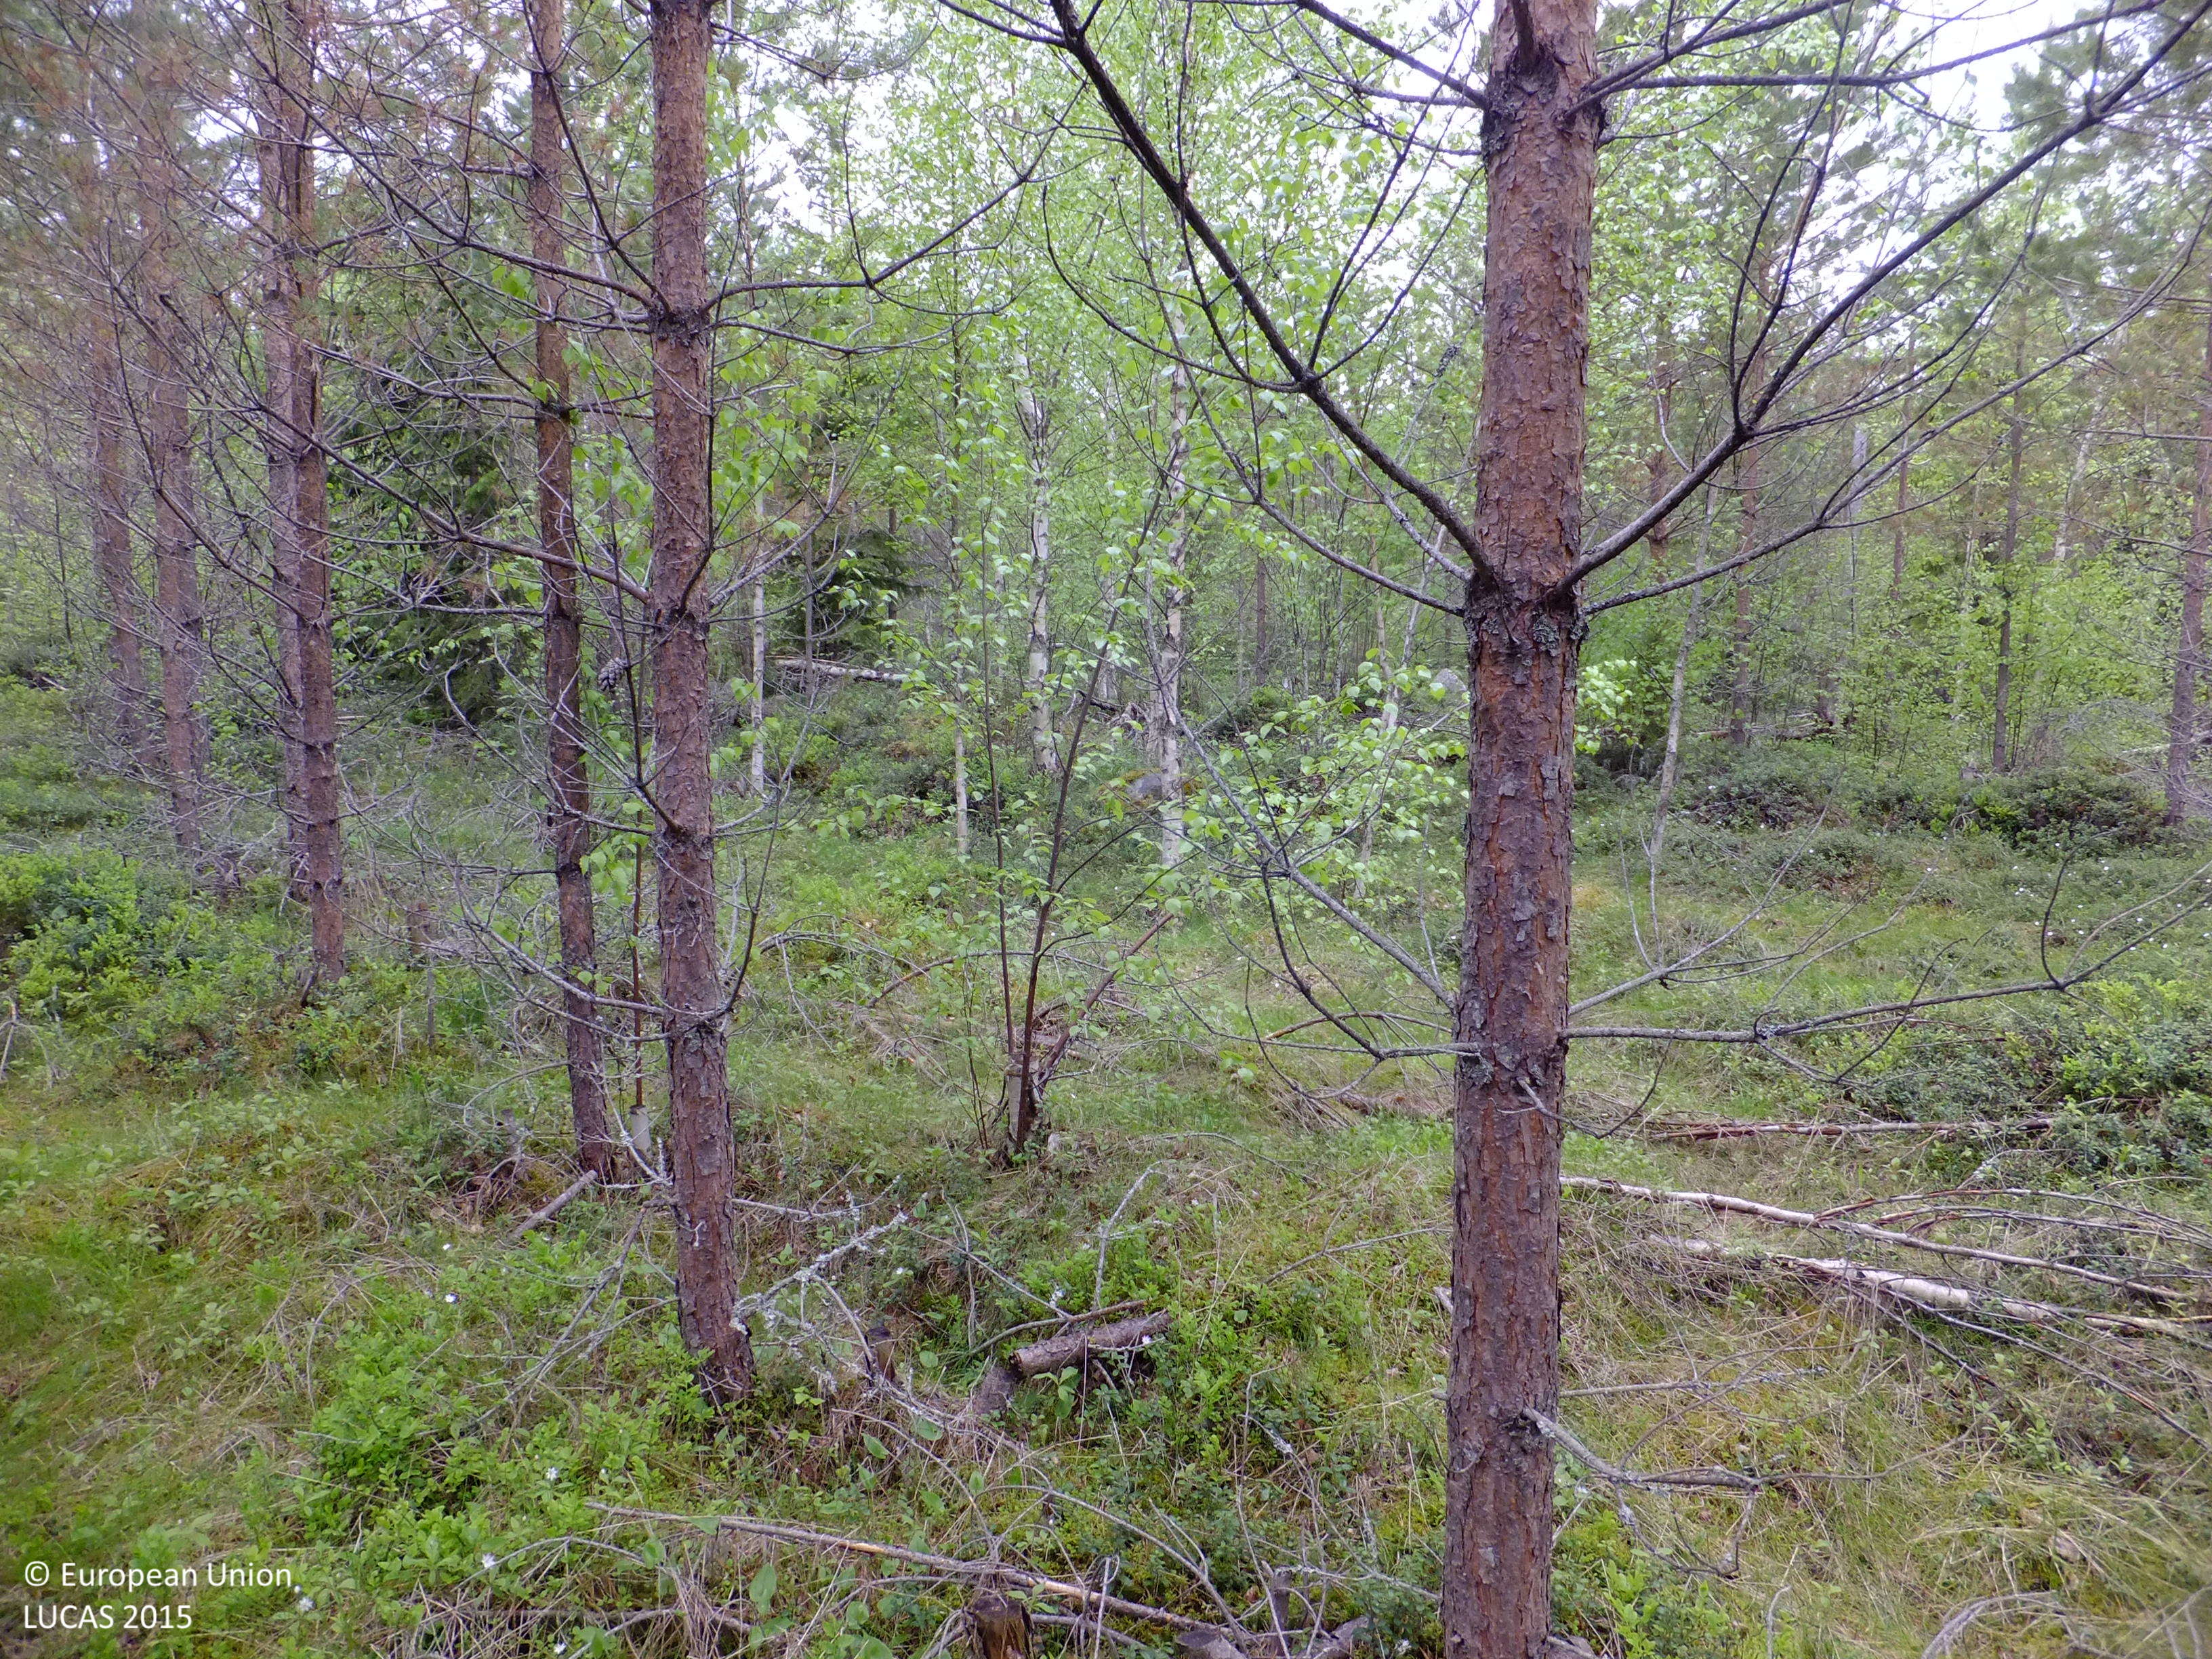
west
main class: Woodland
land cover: Pine dominated mixed woodland
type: boreal forest
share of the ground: > 75 %
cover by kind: coniferous forest trees 55 %, broadleaved forest trees 20 %, herbaceous plants 15 %, shrubs 10 %
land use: Forestry
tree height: < 5 m
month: June
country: FI
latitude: 63.4621
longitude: 23.1569
